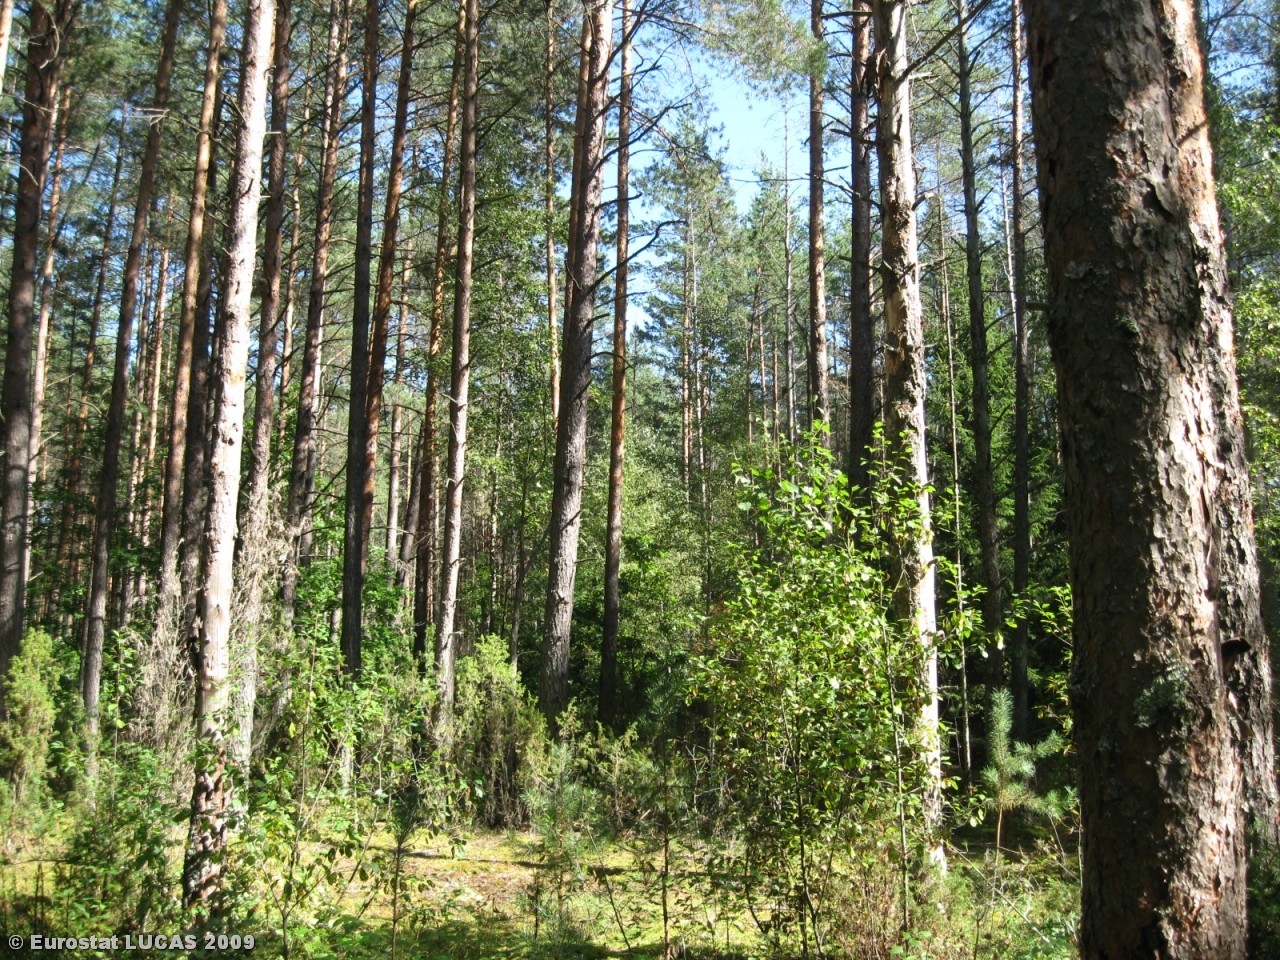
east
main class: Woodland
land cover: Mixed woodland
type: hemiboreal forest and nemoral coniferous forest and mixed broadleaved-coniferous forest
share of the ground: > 75 %
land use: Forestry
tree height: > 5 m
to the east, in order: Mixed woodland; Tracks; Coniferous woodland; Tracks; Coniferous woodland; Mixed woodland
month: August
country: LT
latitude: 54.3173
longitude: 24.6338
